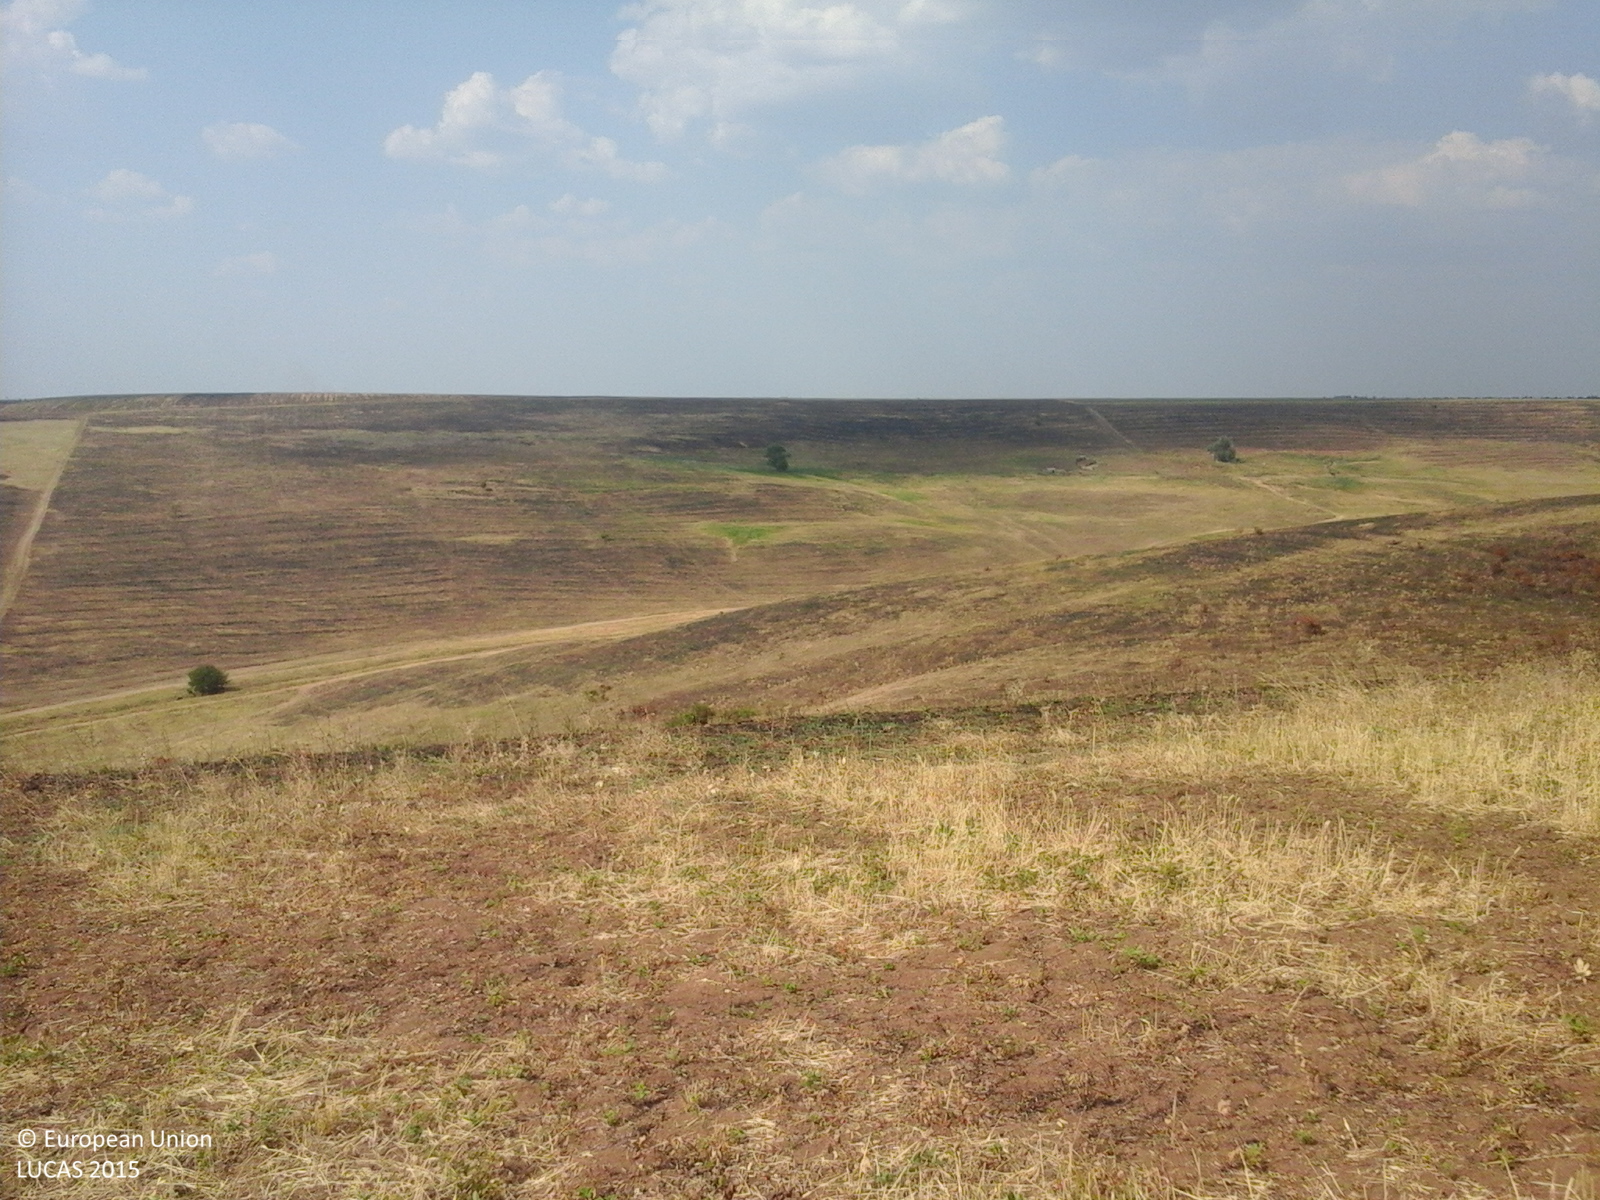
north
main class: Cropland
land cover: Common wheat
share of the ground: < 10 %
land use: Agriculture (excluding fallow land and kitchen gardens)
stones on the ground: < 10 %
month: August
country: RO
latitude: 44.3611
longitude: 23.0567
